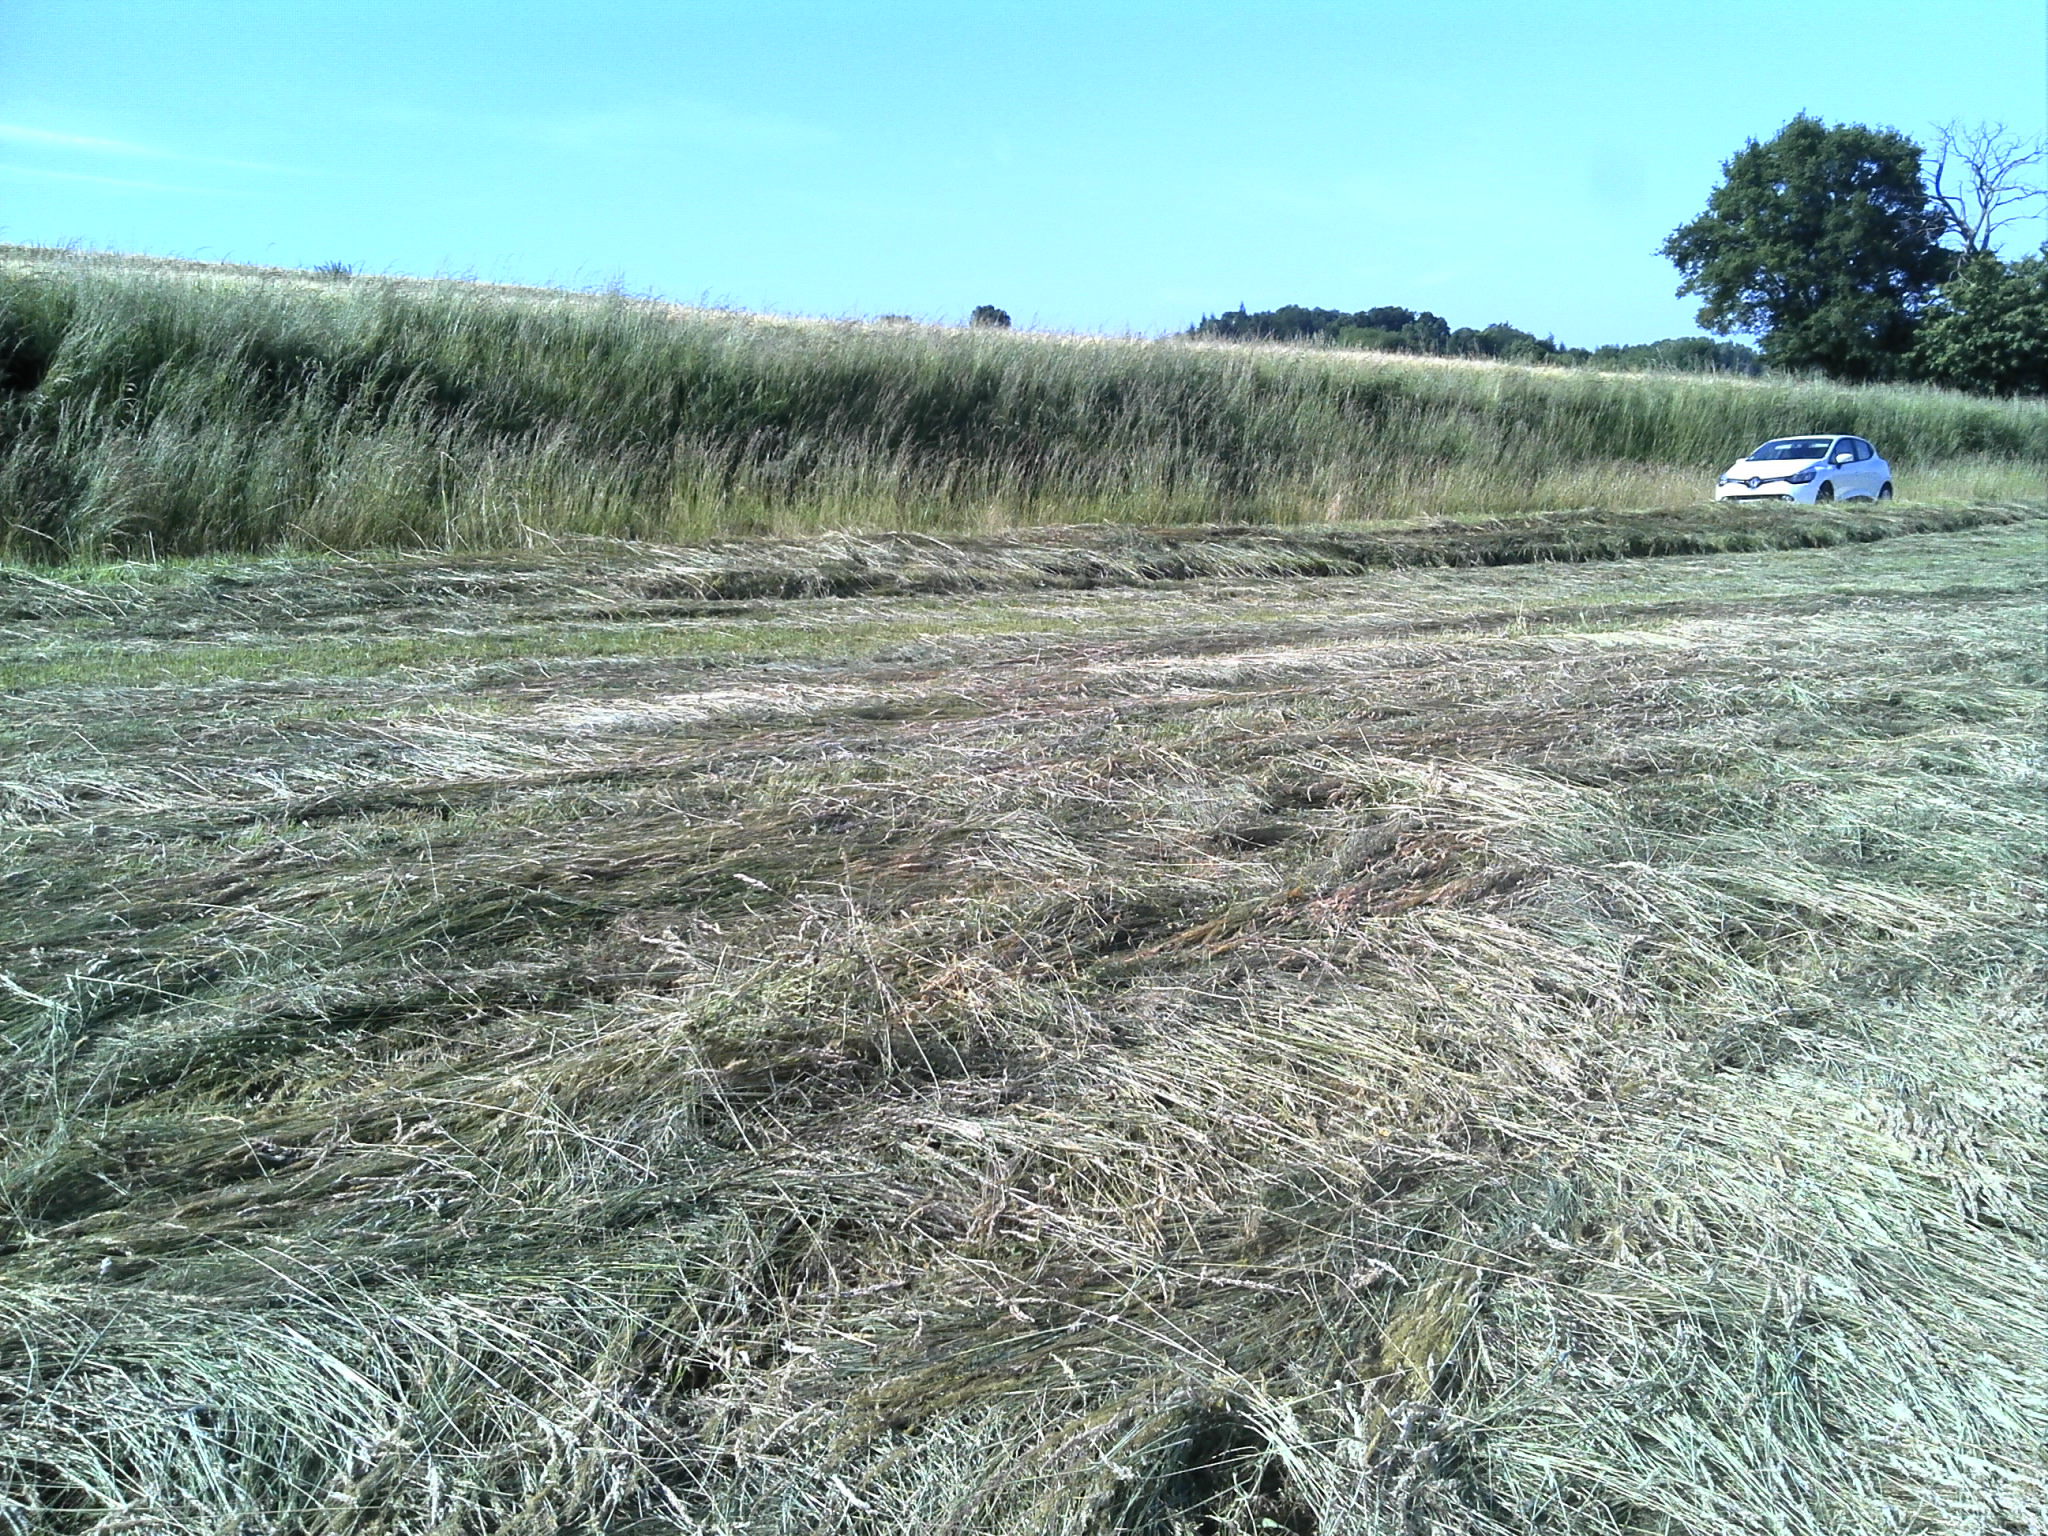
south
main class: Grassland
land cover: Grassland without tree/shrub cover
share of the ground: > 75 %
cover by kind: herbaceous plants 100 %
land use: Agriculture (excluding fallow land and kitchen gardens)
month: June
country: FR
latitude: 47.2050
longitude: 1.4719
